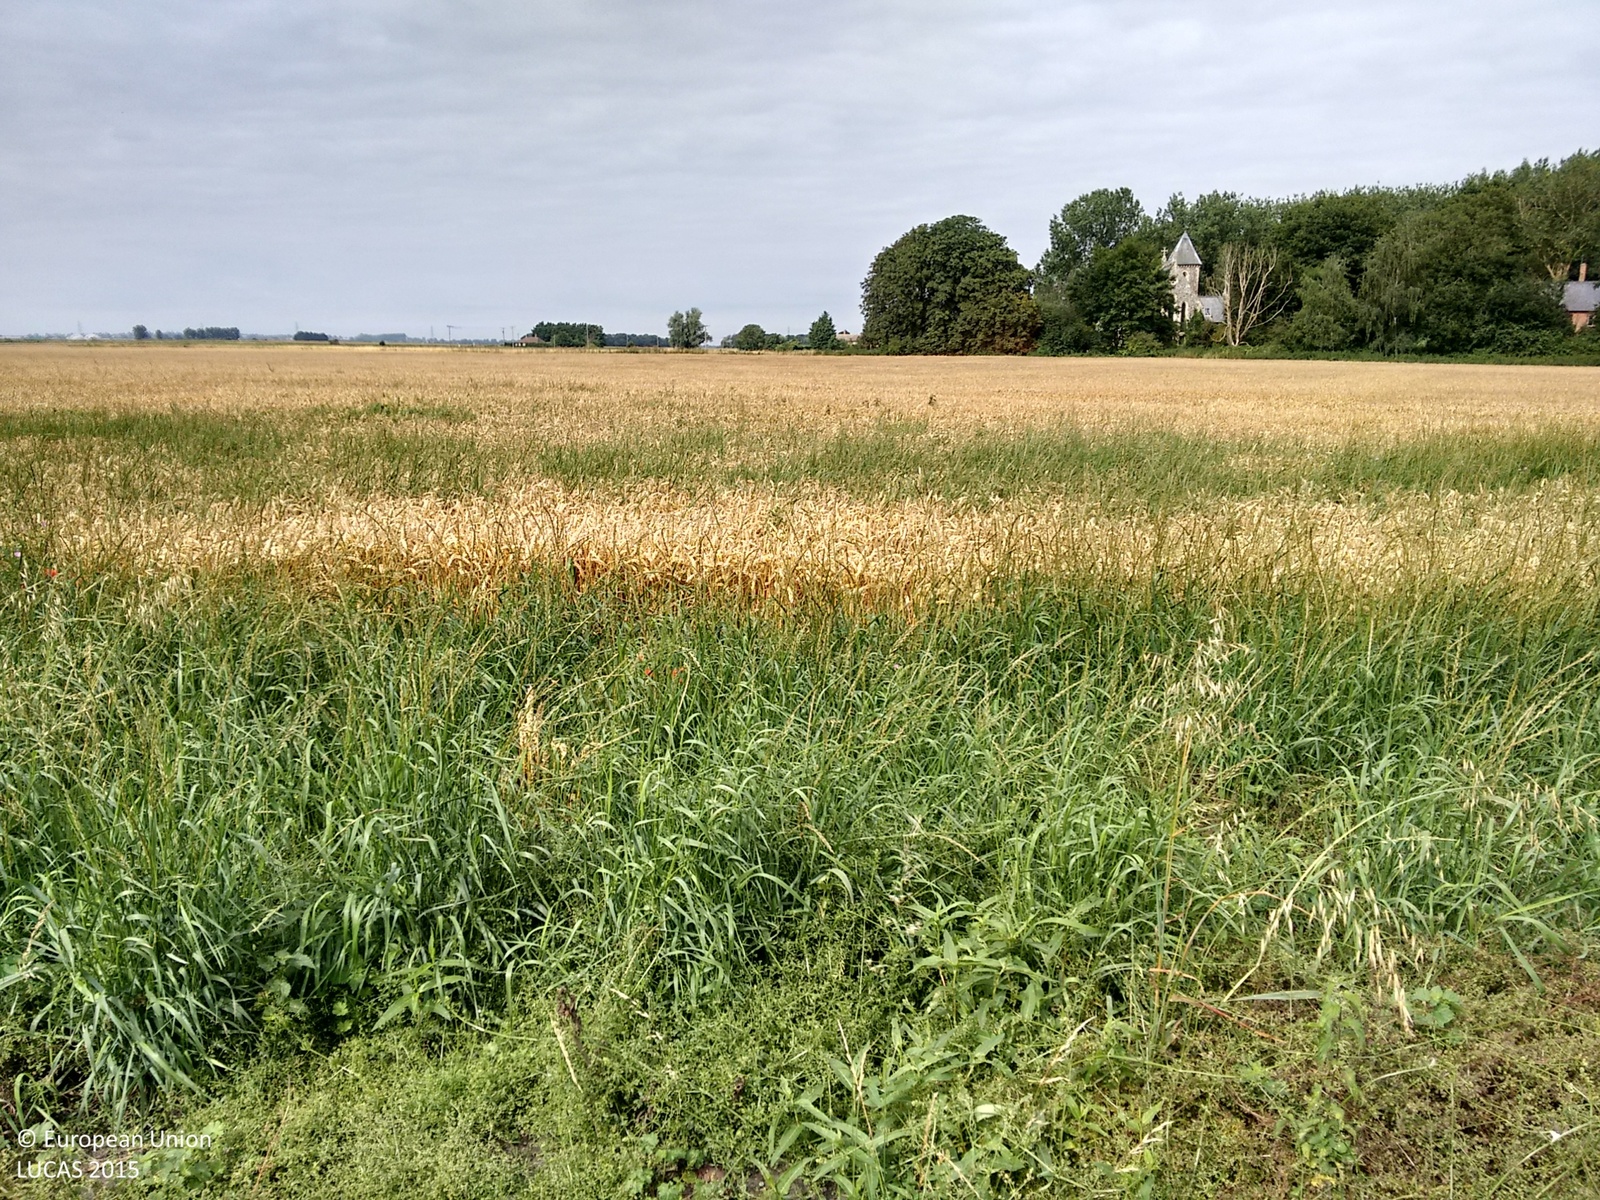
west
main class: Cropland
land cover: Common wheat
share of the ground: > 75 %
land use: Agriculture (excluding fallow land and kitchen gardens)
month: August
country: GB
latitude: 52.4755
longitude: 0.3870
